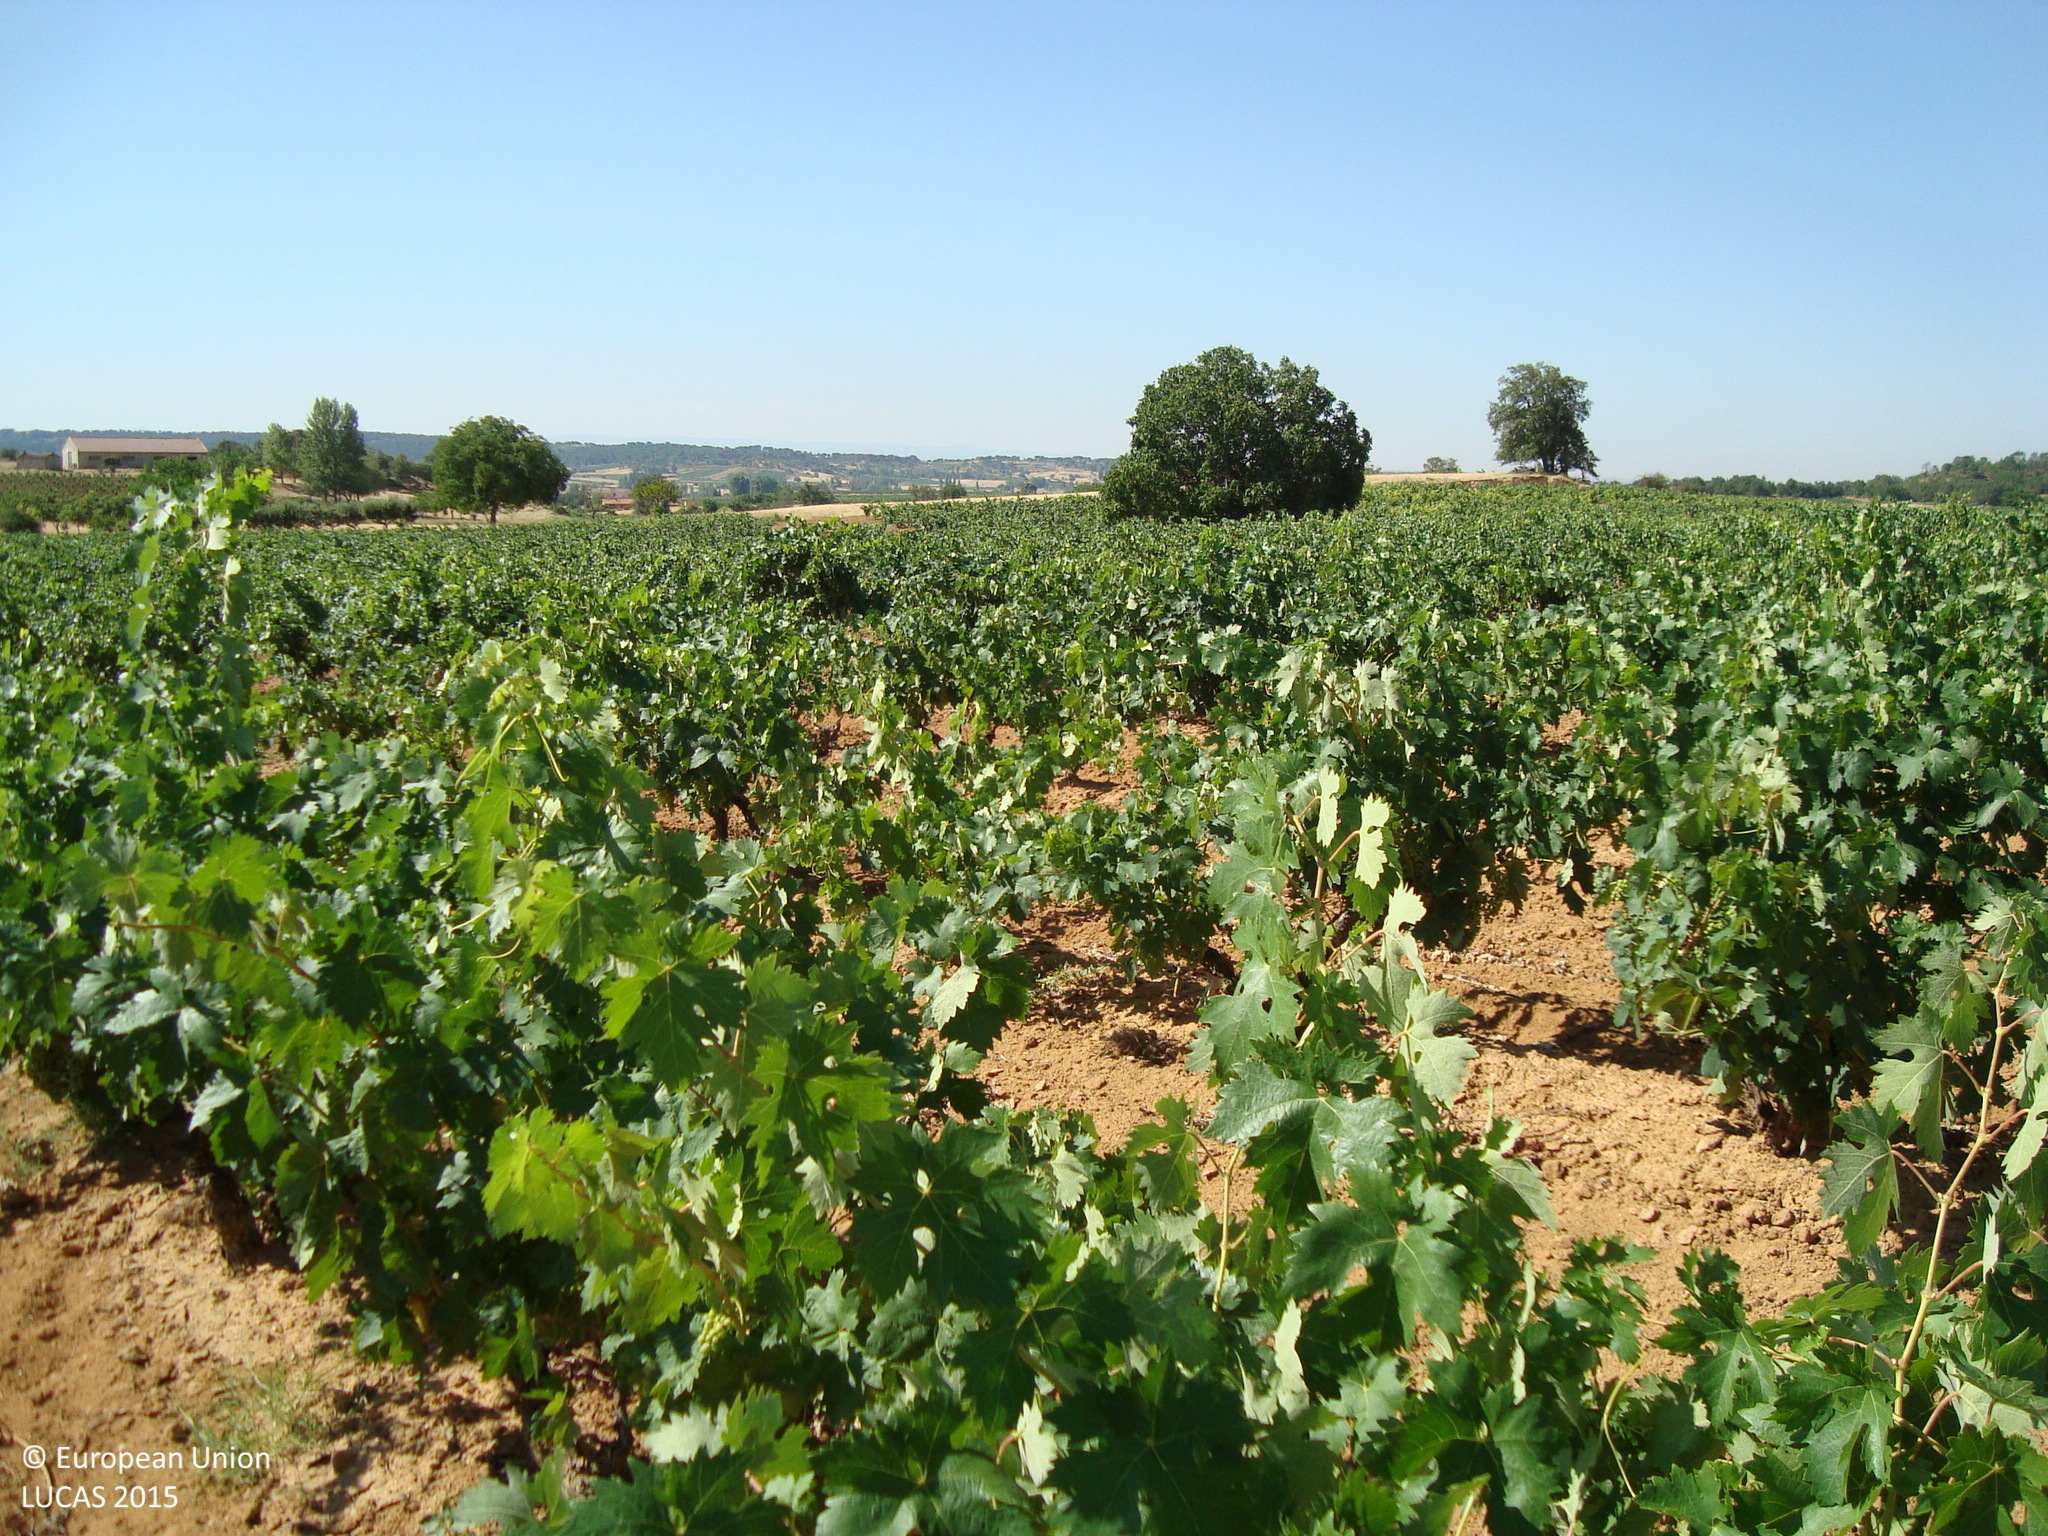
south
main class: Cropland
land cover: Vineyards
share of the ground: 25 - 50 %
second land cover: Other bare soil
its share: > 75 %
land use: Agriculture (excluding fallow land and kitchen gardens)
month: July
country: ES
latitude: 41.7654
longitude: -3.7555
